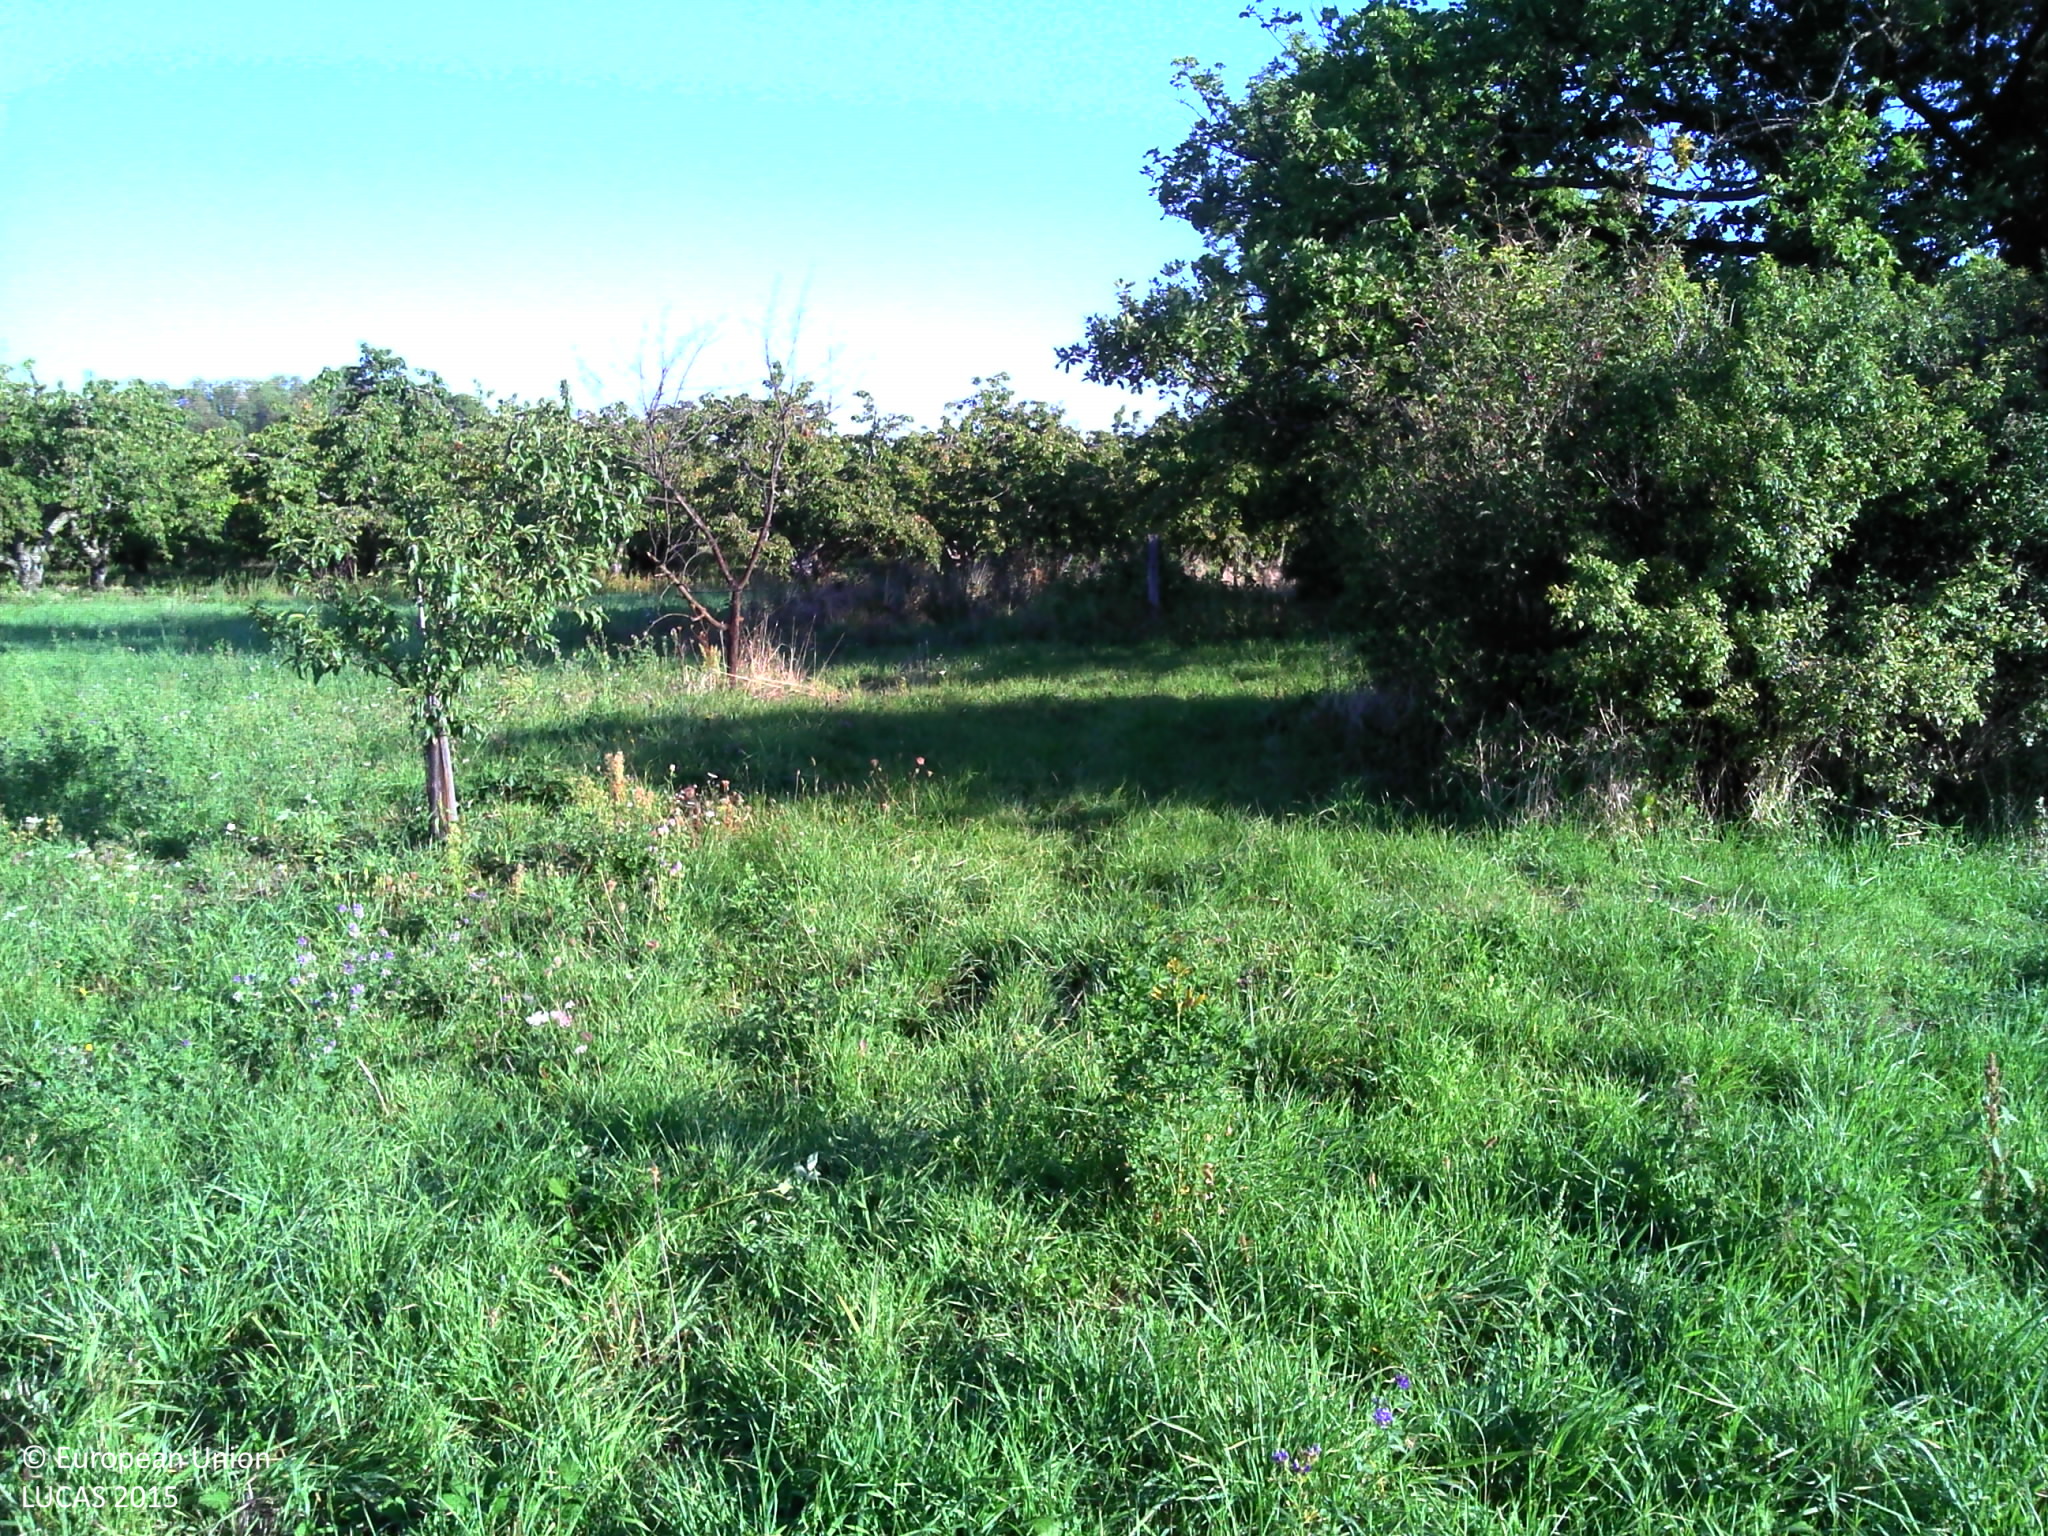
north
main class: Grassland
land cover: Grassland with sparse tree/shrub cover
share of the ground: > 75 %
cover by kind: herbaceous plants 95 %, broadleaved forest trees 5 %
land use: Agriculture (excluding fallow land and kitchen gardens)
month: September
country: FR
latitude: 45.8364
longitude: 3.0600
